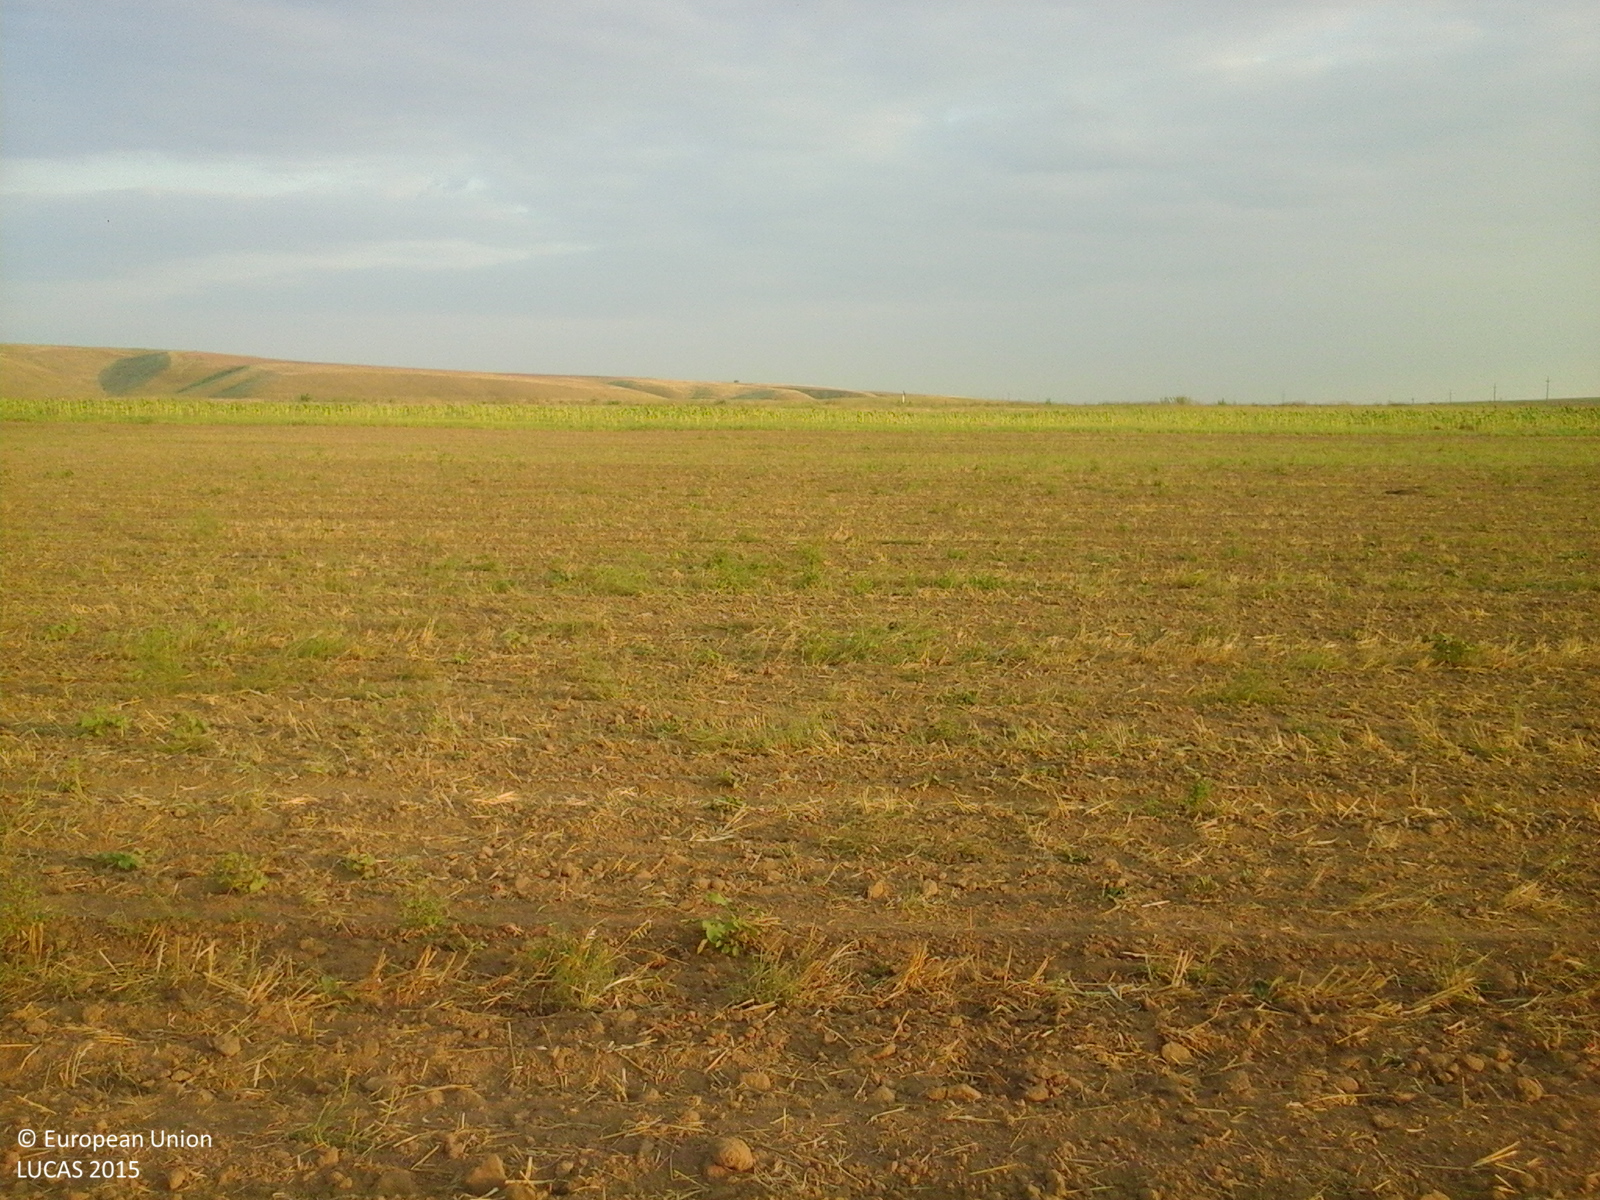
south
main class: Cropland
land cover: Common wheat
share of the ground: < 10 %
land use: Agriculture (excluding fallow land and kitchen gardens)
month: August
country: RO
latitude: 44.7073
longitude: 28.0468
